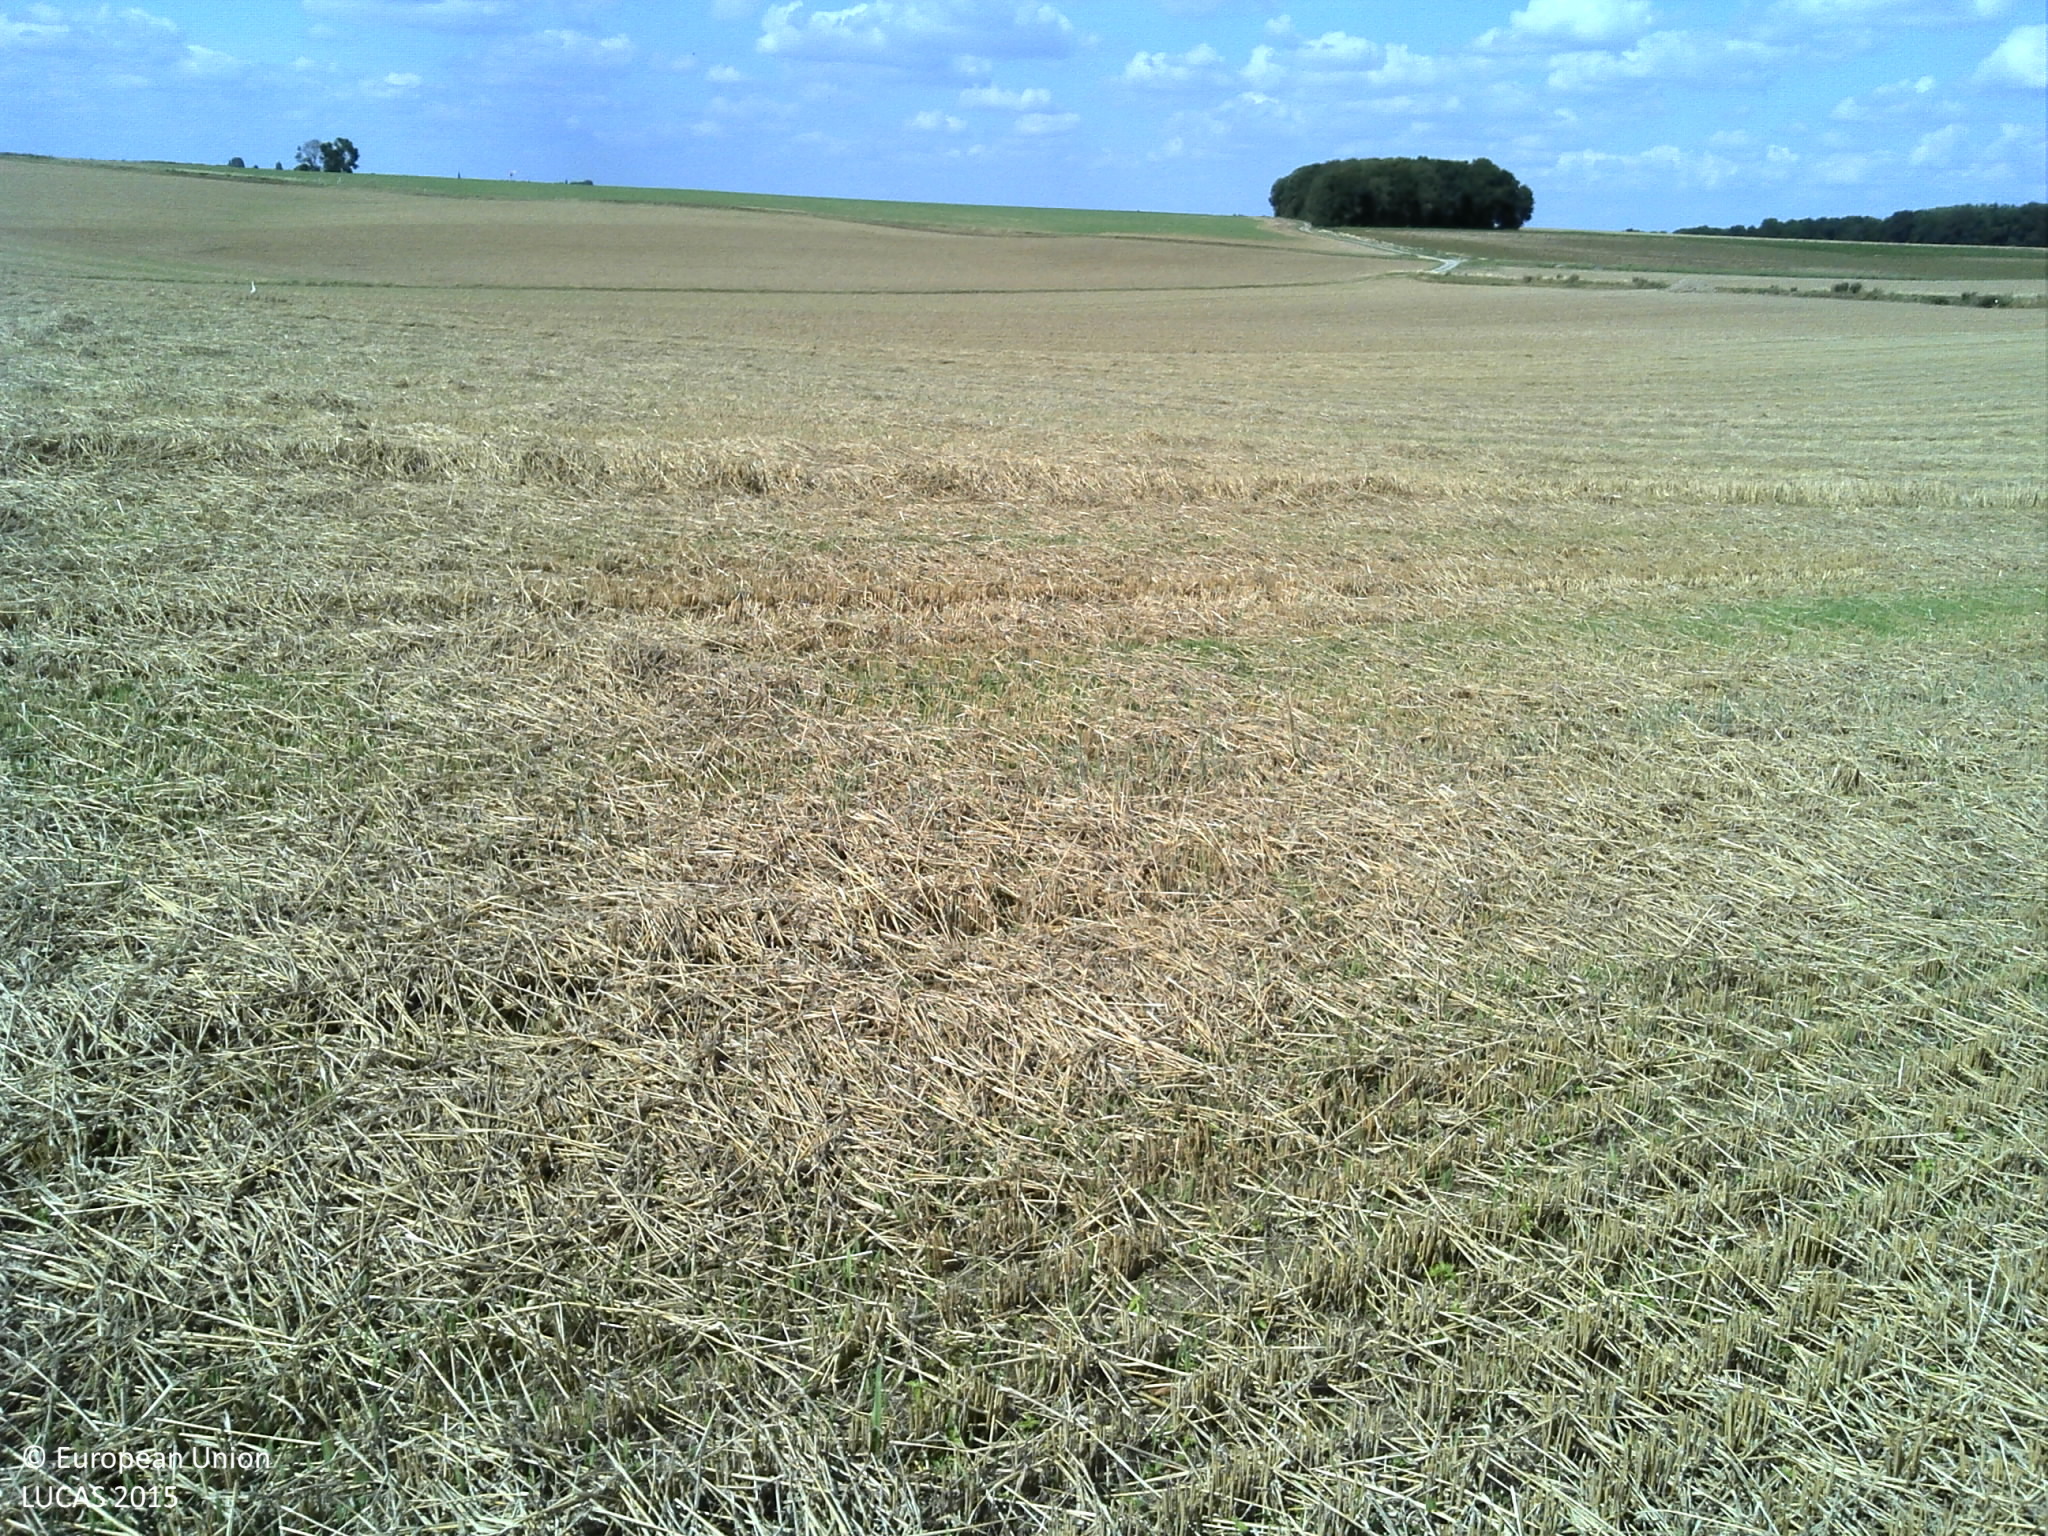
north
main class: Cropland
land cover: Barley
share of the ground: 10 - 25 %
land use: Agriculture (excluding fallow land and kitchen gardens)
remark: Harvested field
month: August
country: FR
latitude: 49.9778
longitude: 3.1441
